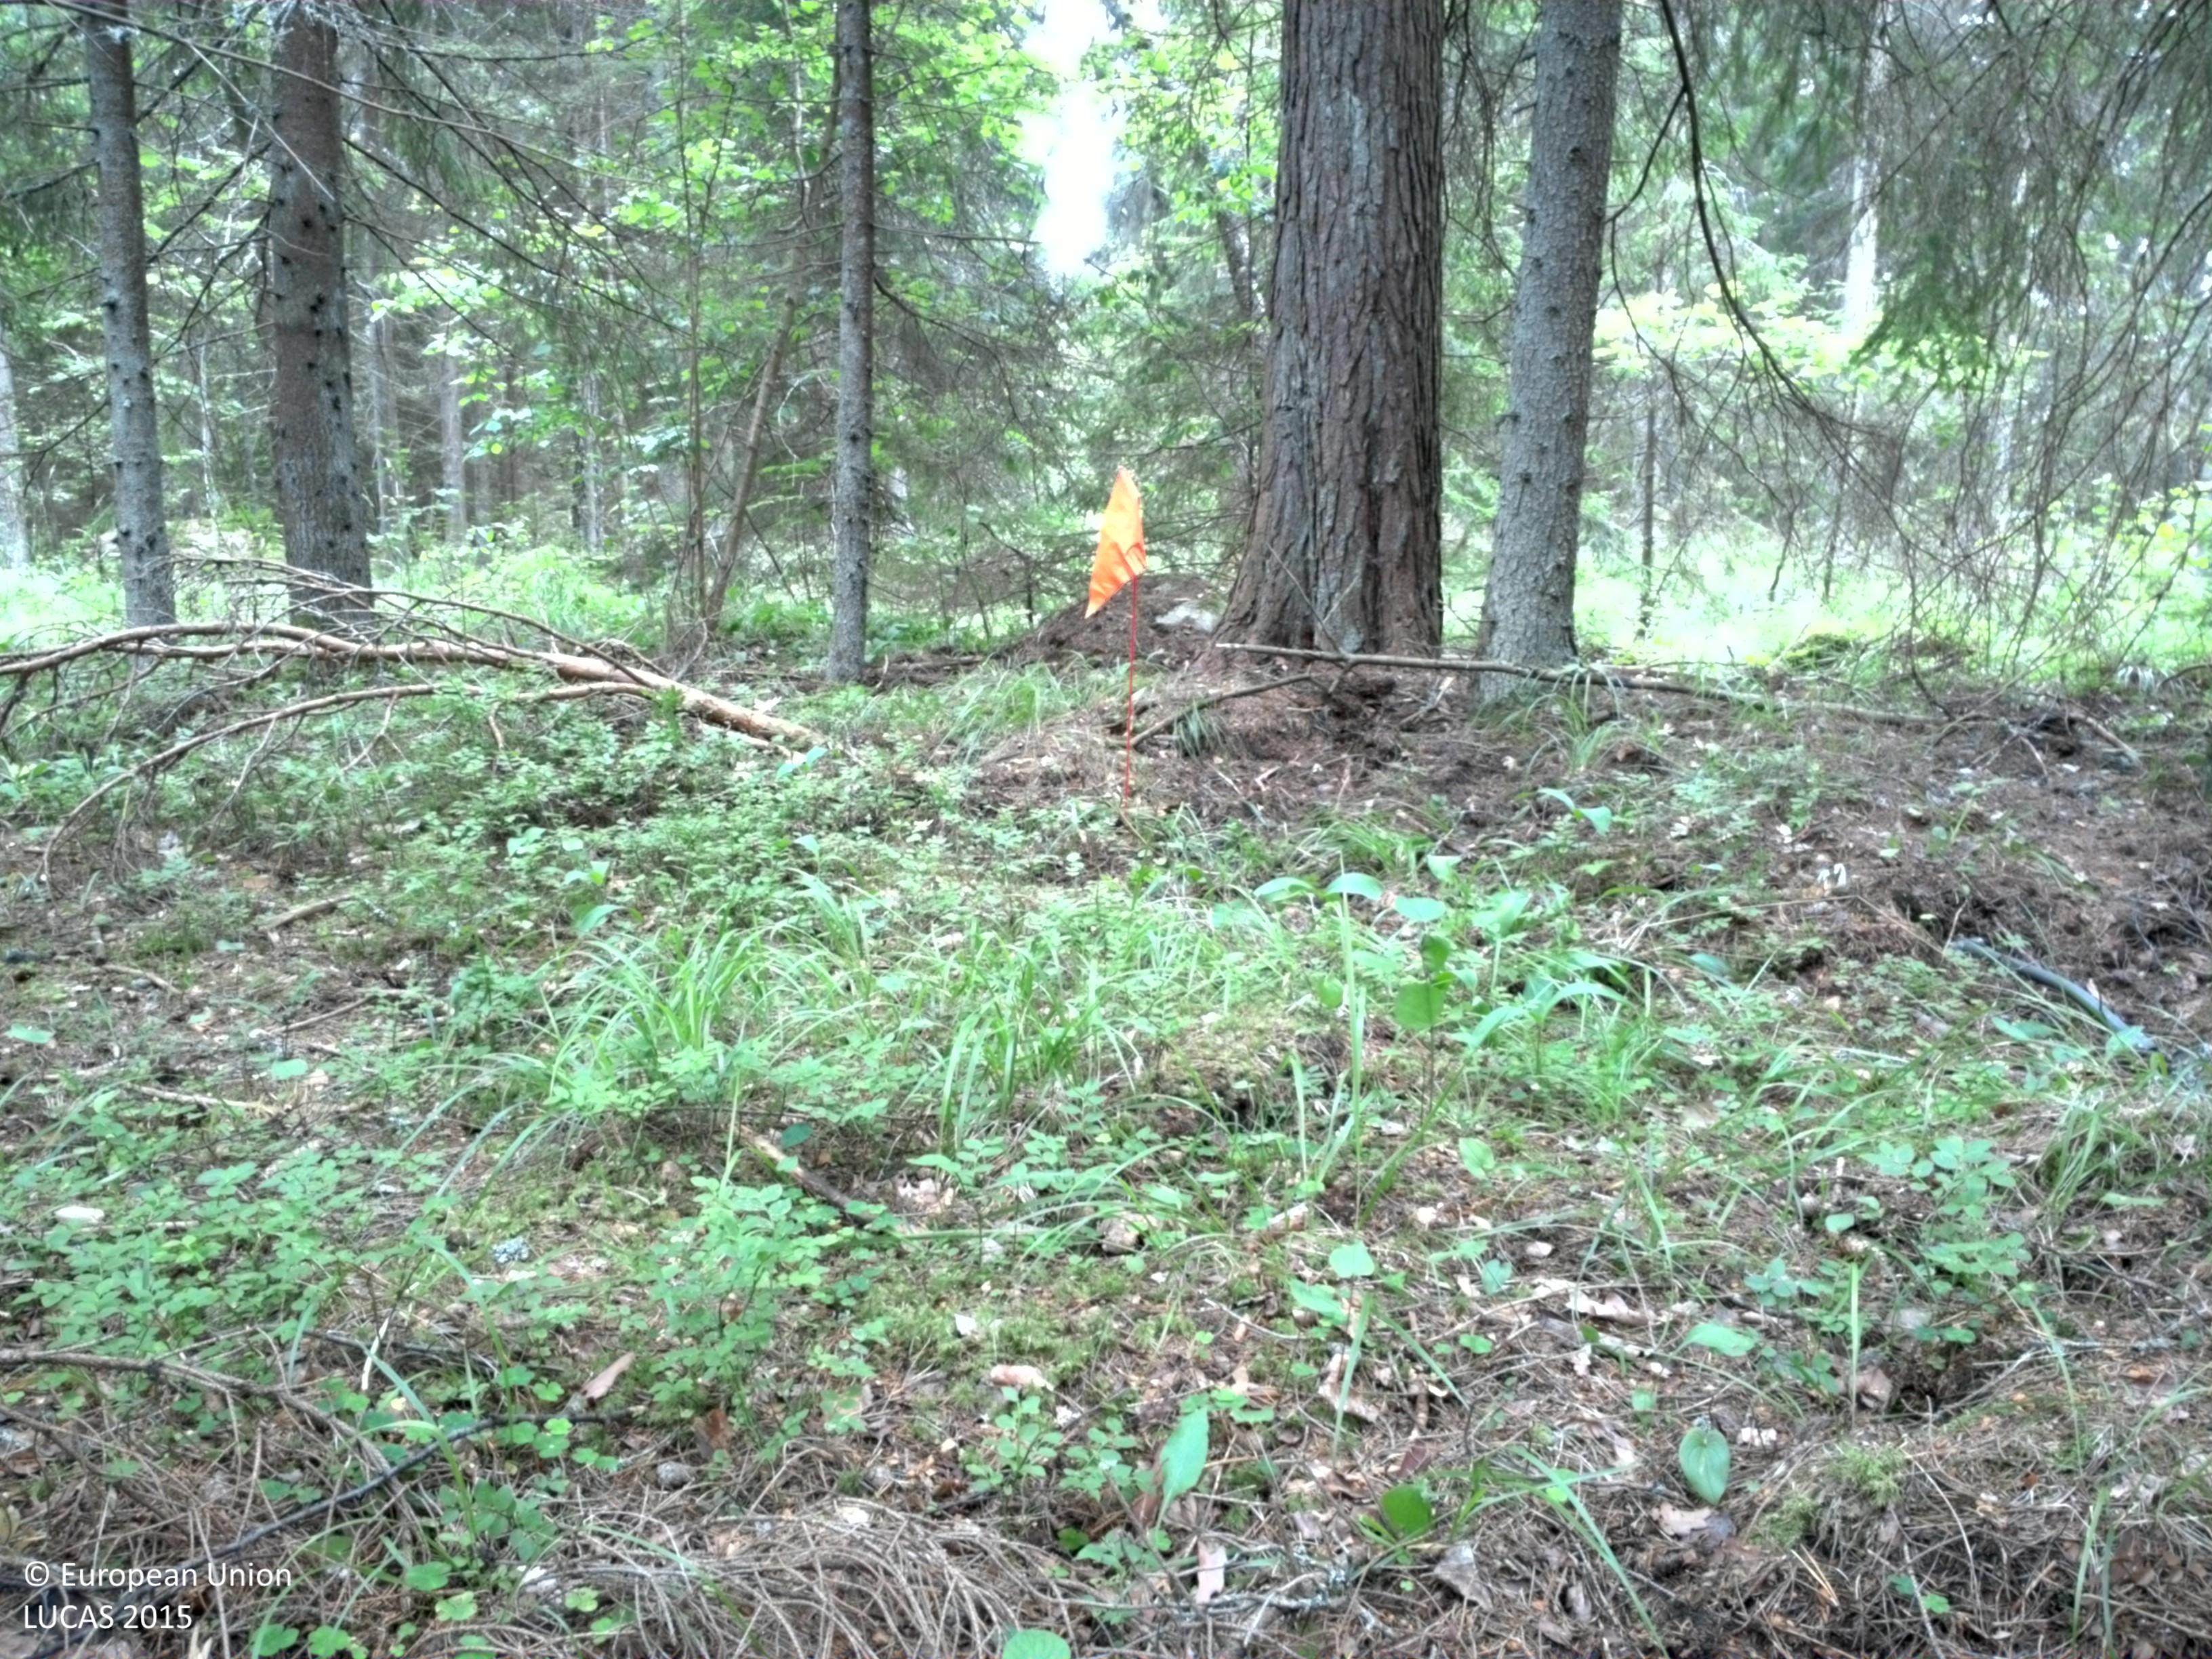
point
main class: Woodland
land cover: Spruce dominated coniferous woodland
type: boreal forest
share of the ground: > 75 %
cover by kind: coniferous forest trees 65 %, broadleaved forest trees 10 %, shrubs 10 %, herbaceous plants 10 %, lichens and mosses 5 %
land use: Forestry
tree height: > 5 m
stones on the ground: < 10 %
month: July
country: SE
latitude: 59.8328
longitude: 18.5083
